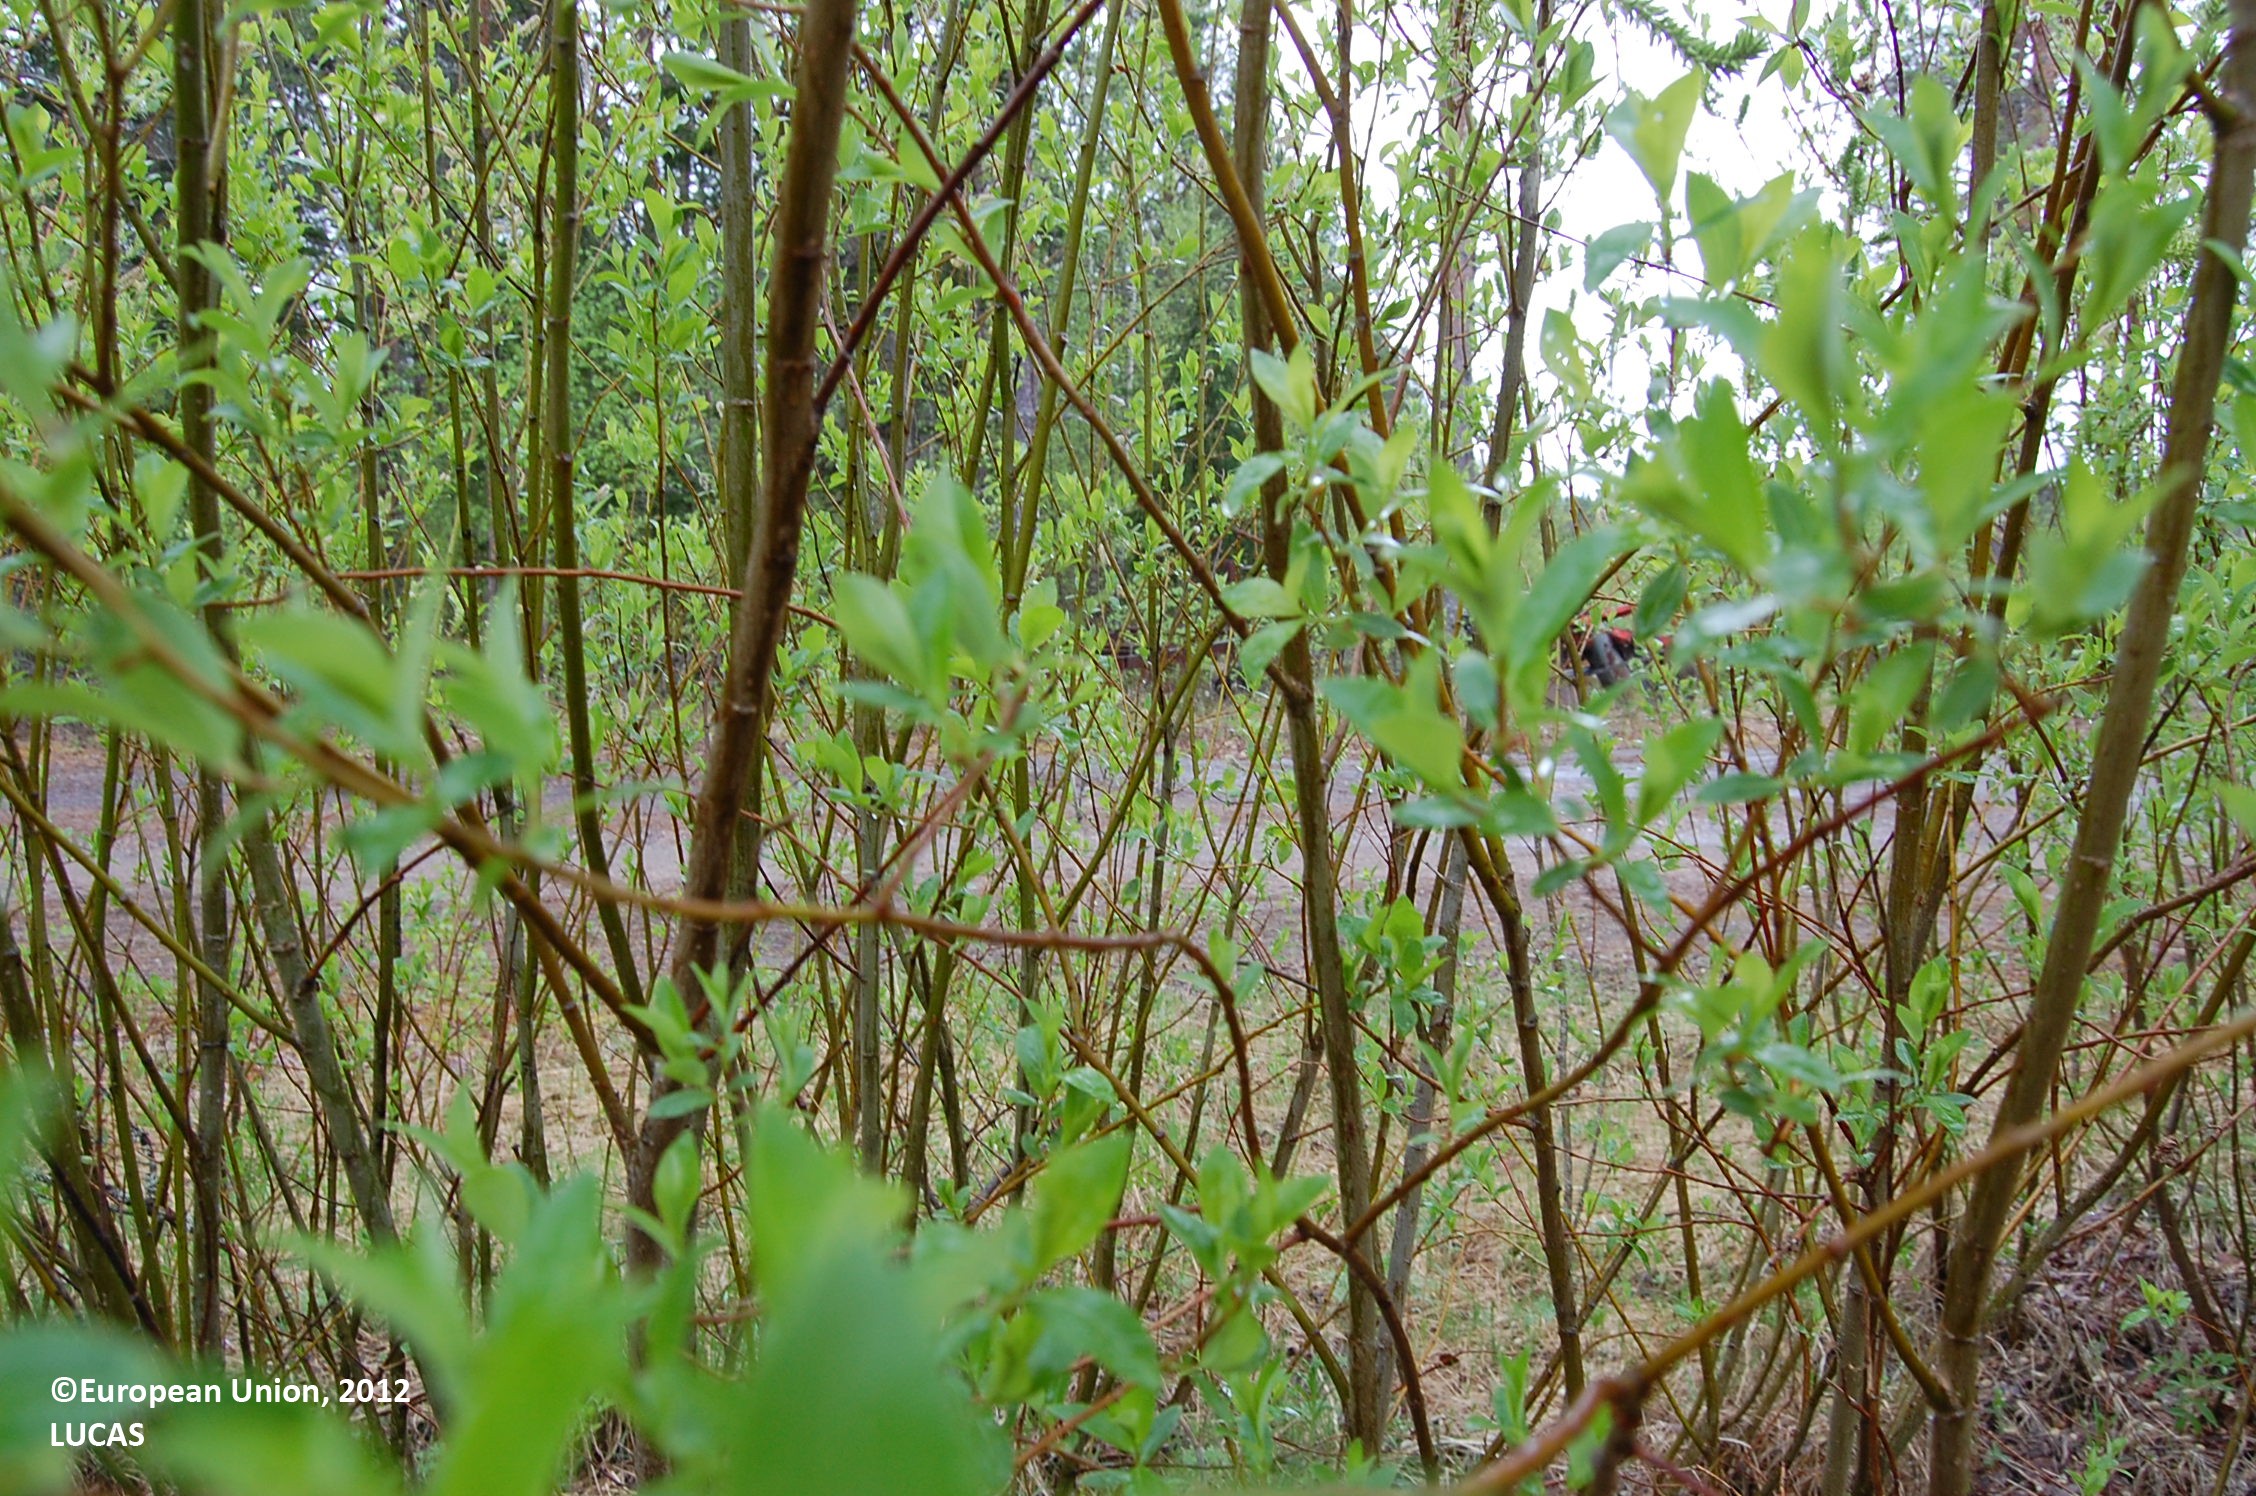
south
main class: Shrubland
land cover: Shrubland without tree cover
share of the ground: > 75 %
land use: Semi-natural and natural areas not in use
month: June
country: FI
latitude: 64.1119
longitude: 27.4094
